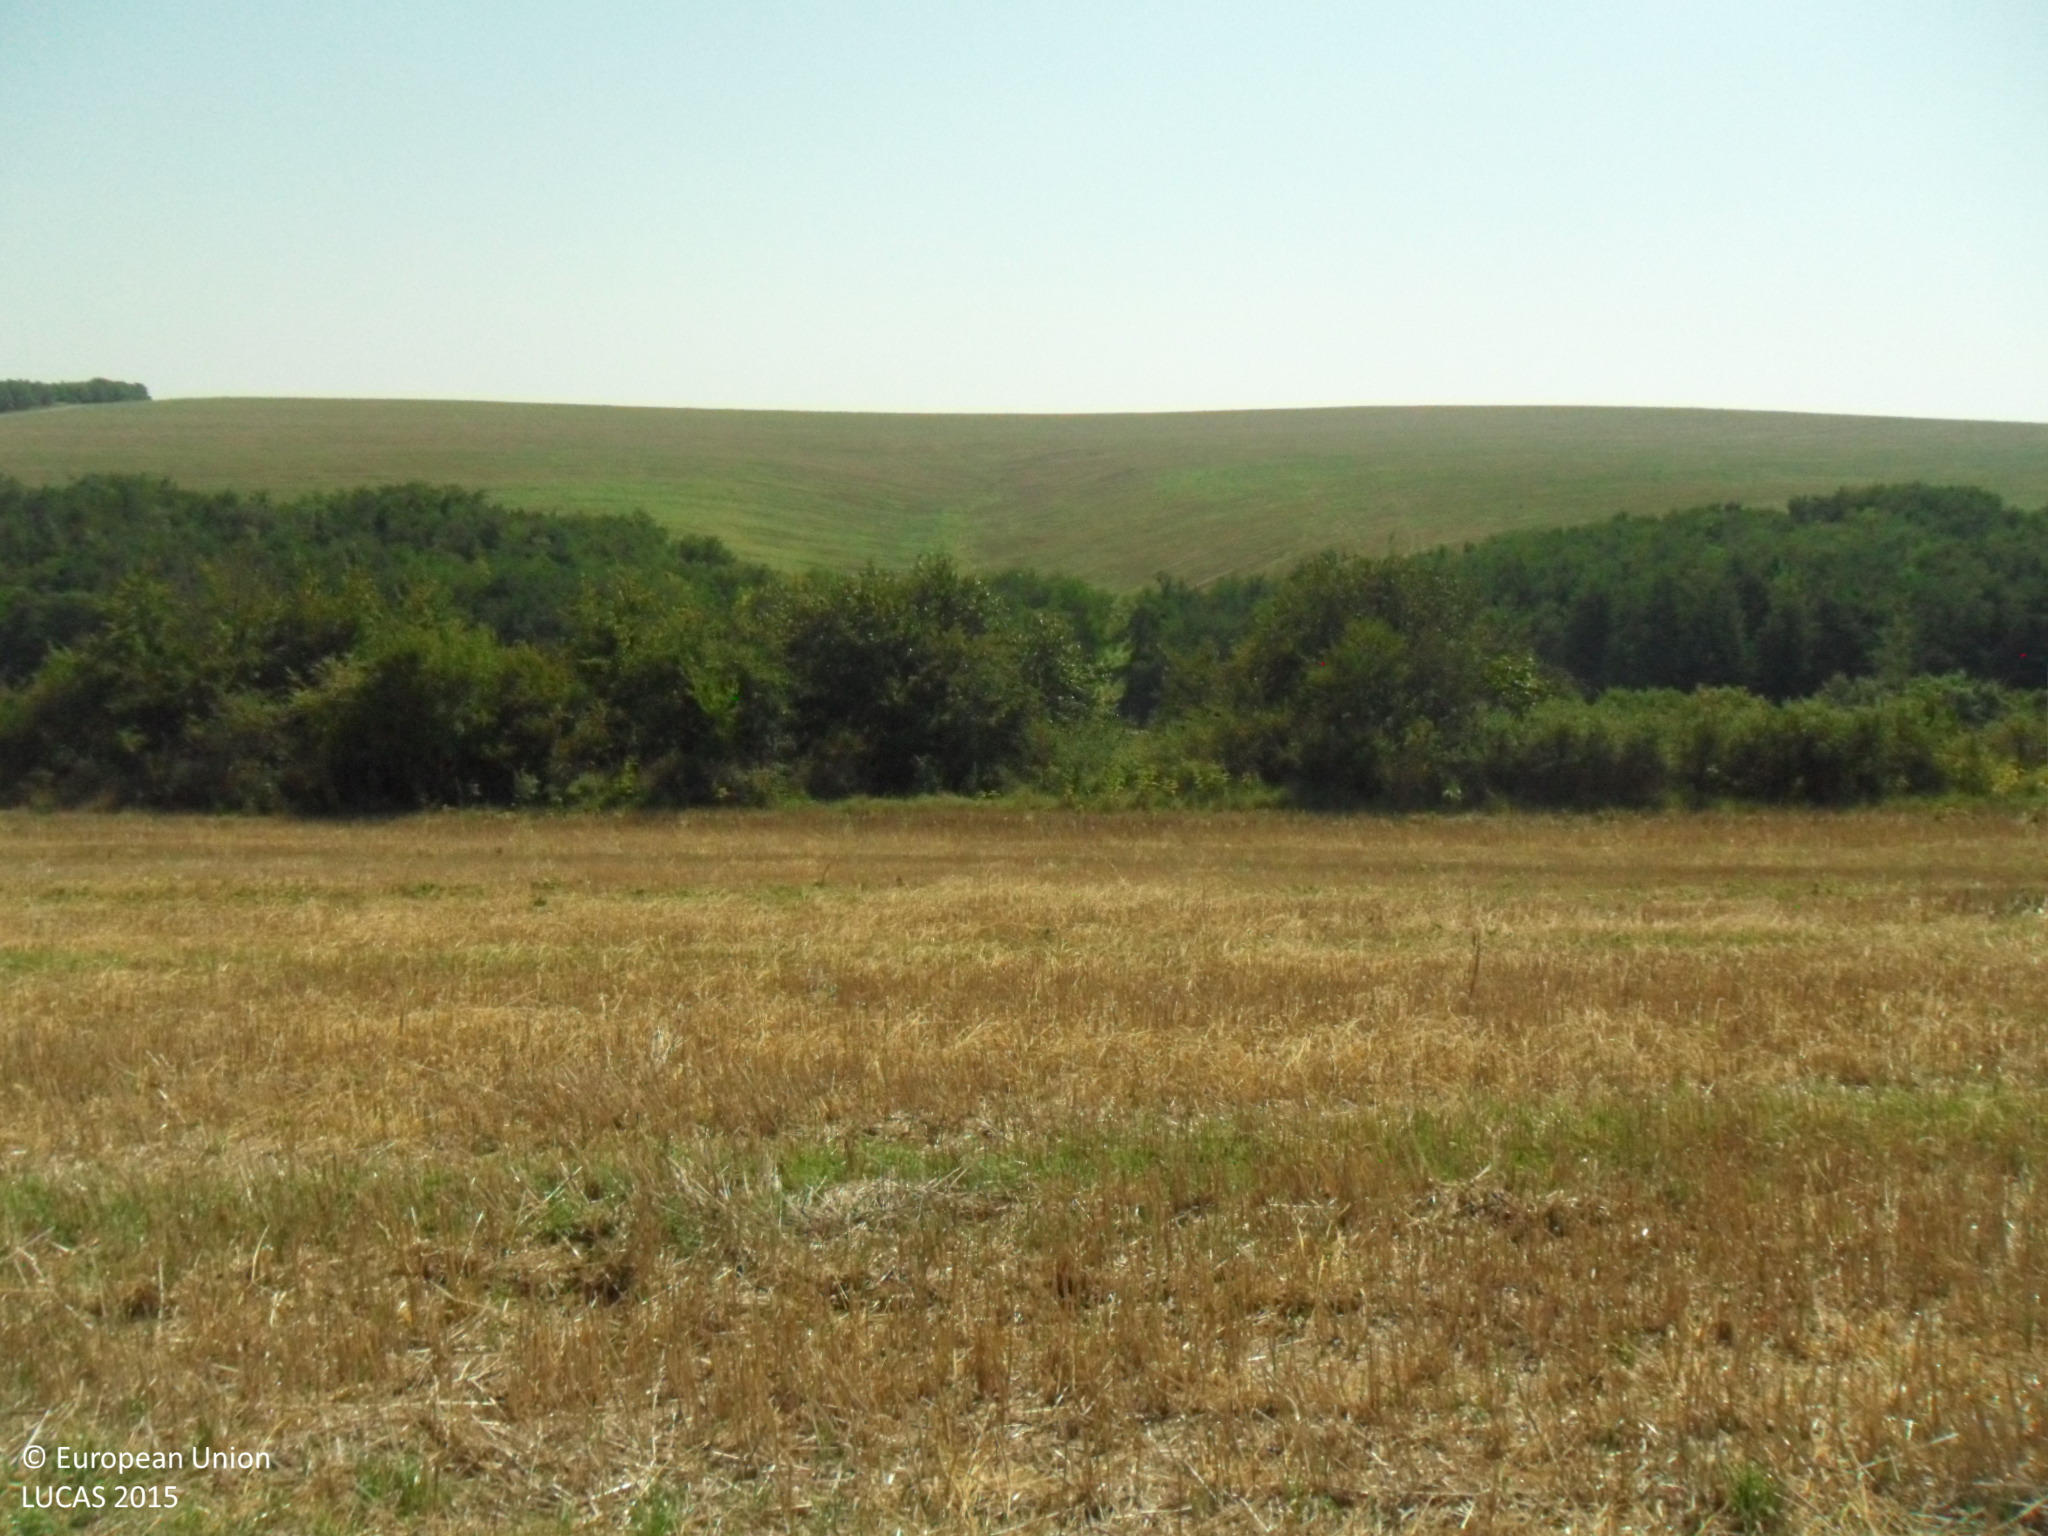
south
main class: Cropland
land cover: Common wheat
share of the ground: 25 - 50 %
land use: Agriculture (excluding fallow land and kitchen gardens)
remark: Harvested field
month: September
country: BG
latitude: 43.5819
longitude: 26.0836
